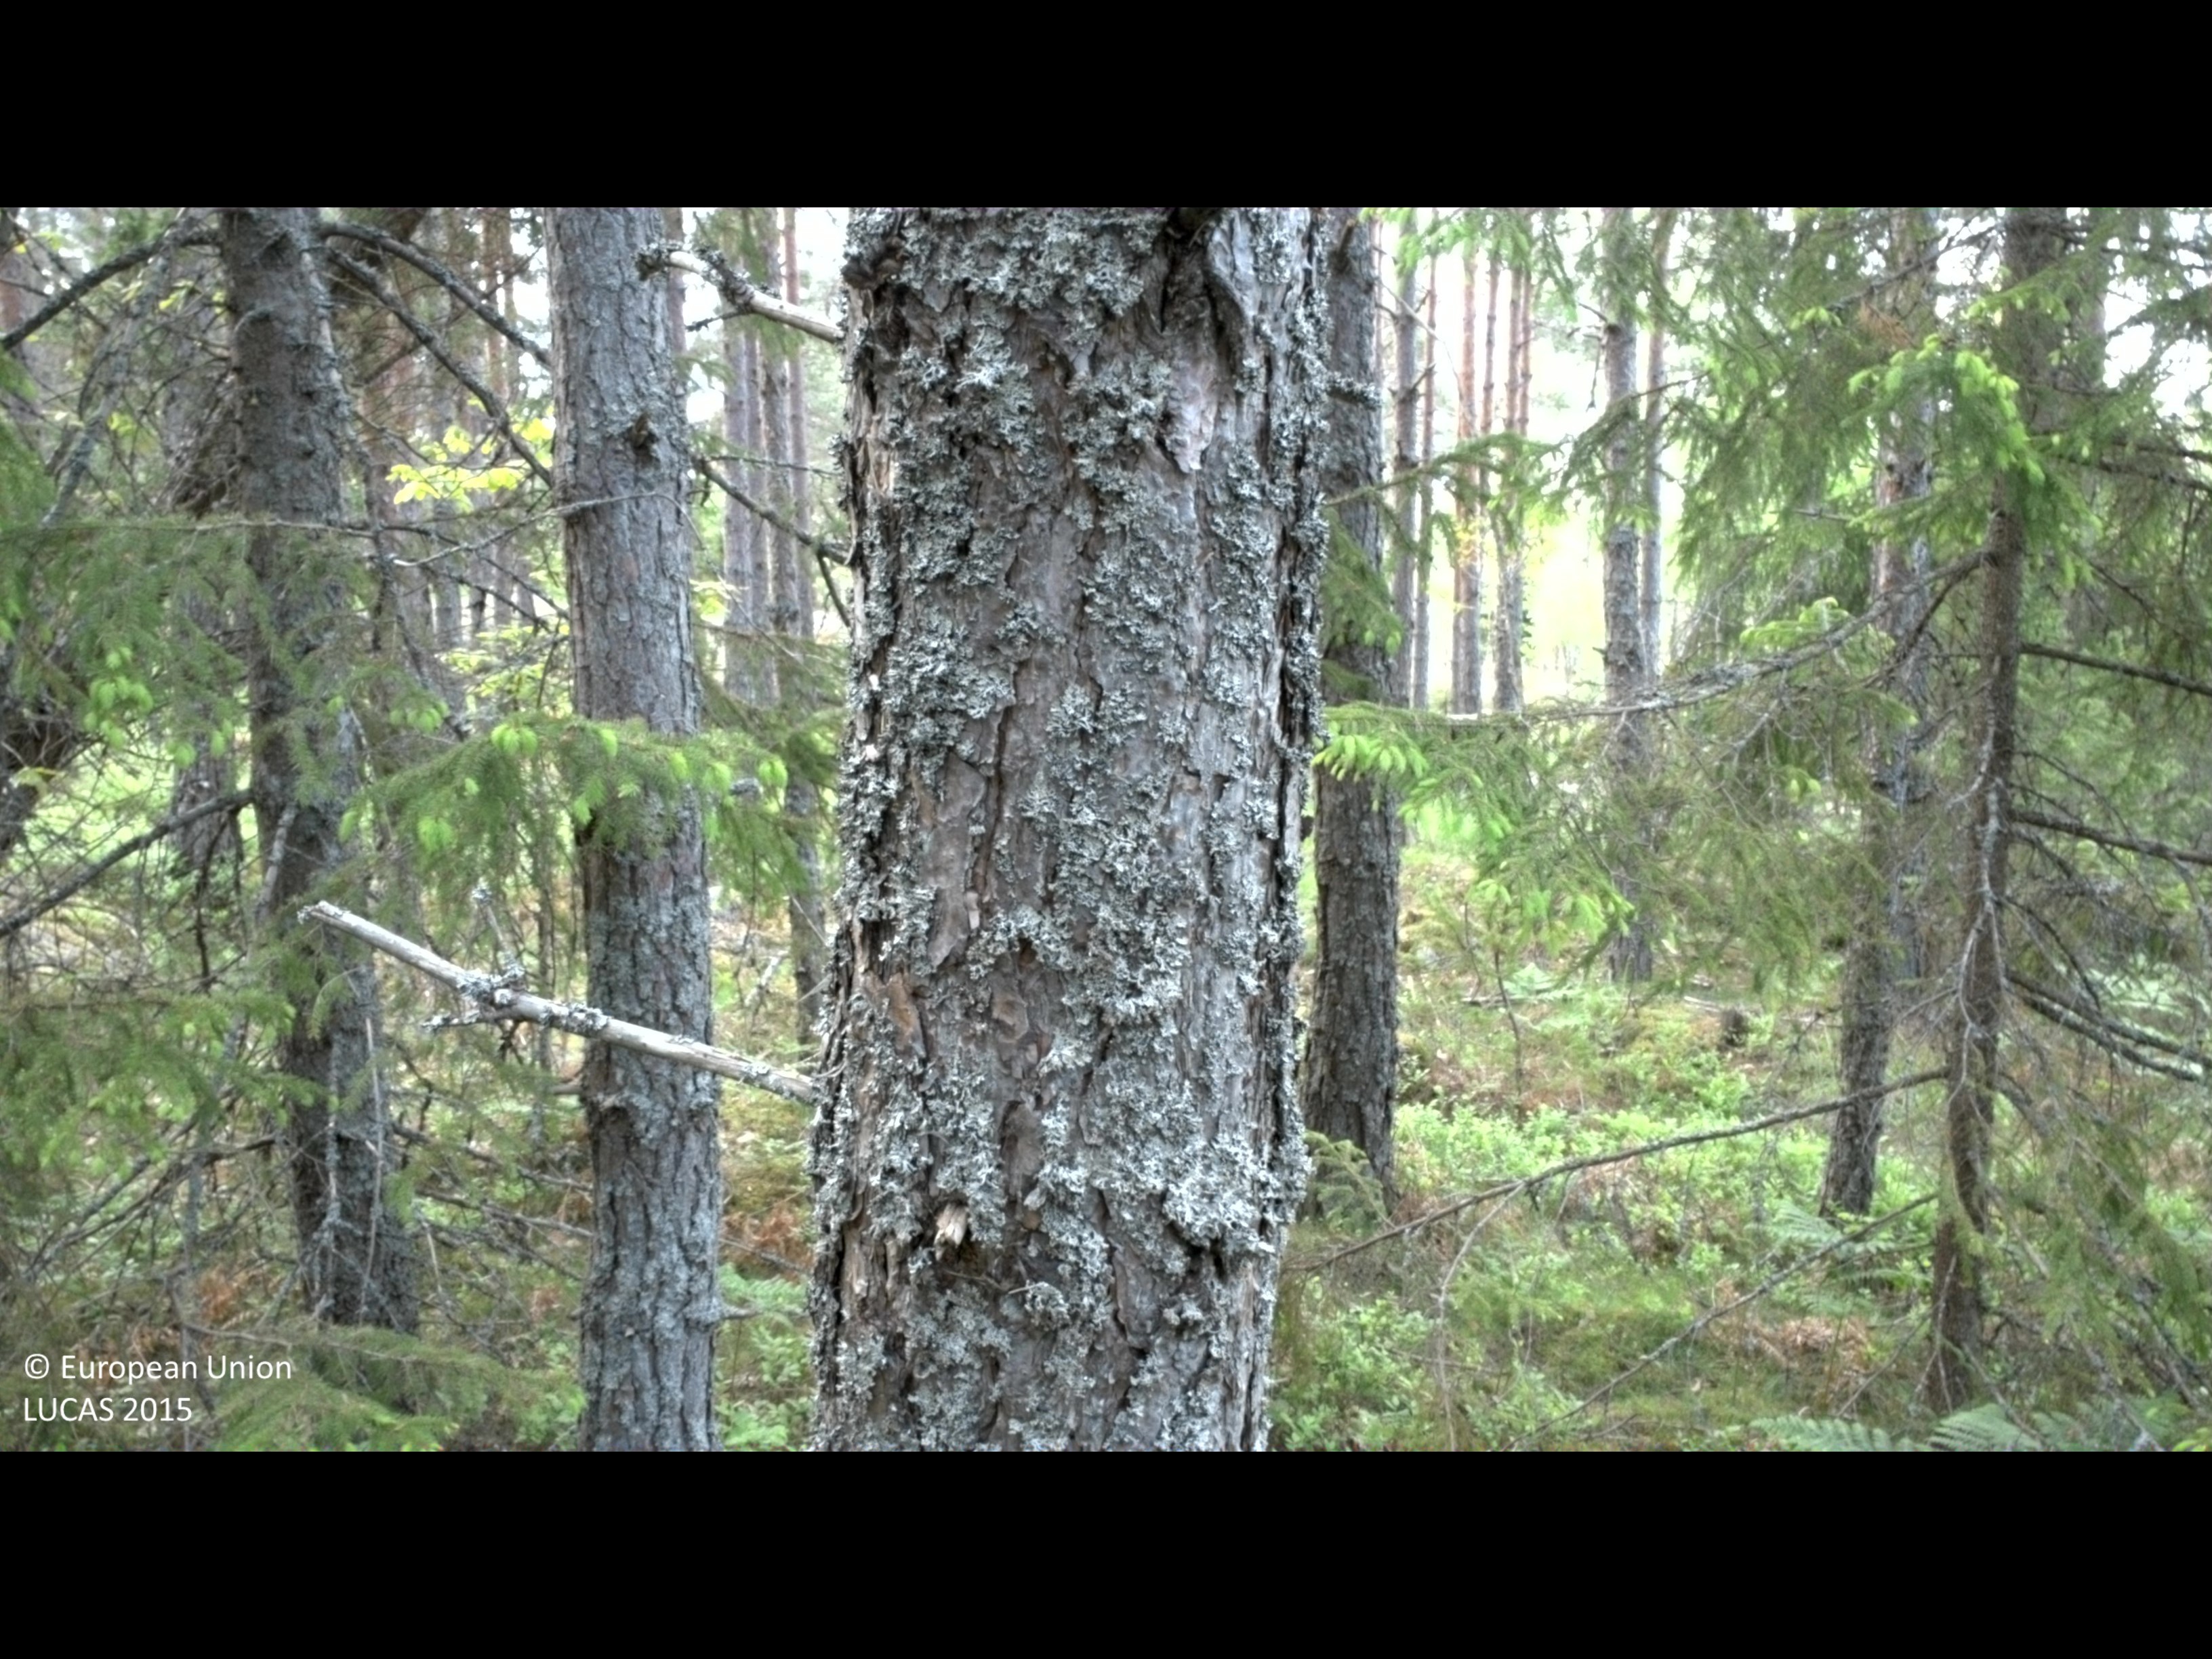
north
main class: Woodland
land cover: Pine dominated coniferous woodland
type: boreal forest
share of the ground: 50 - 75 %
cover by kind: coniferous forest trees 65 %, shrubs 15 %, lichens and mosses 10 %, broadleaved forest trees 5 %, herbaceous plants 5 %
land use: Forestry
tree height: > 5 m
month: May
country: SE
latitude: 57.4494
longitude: 16.4816
